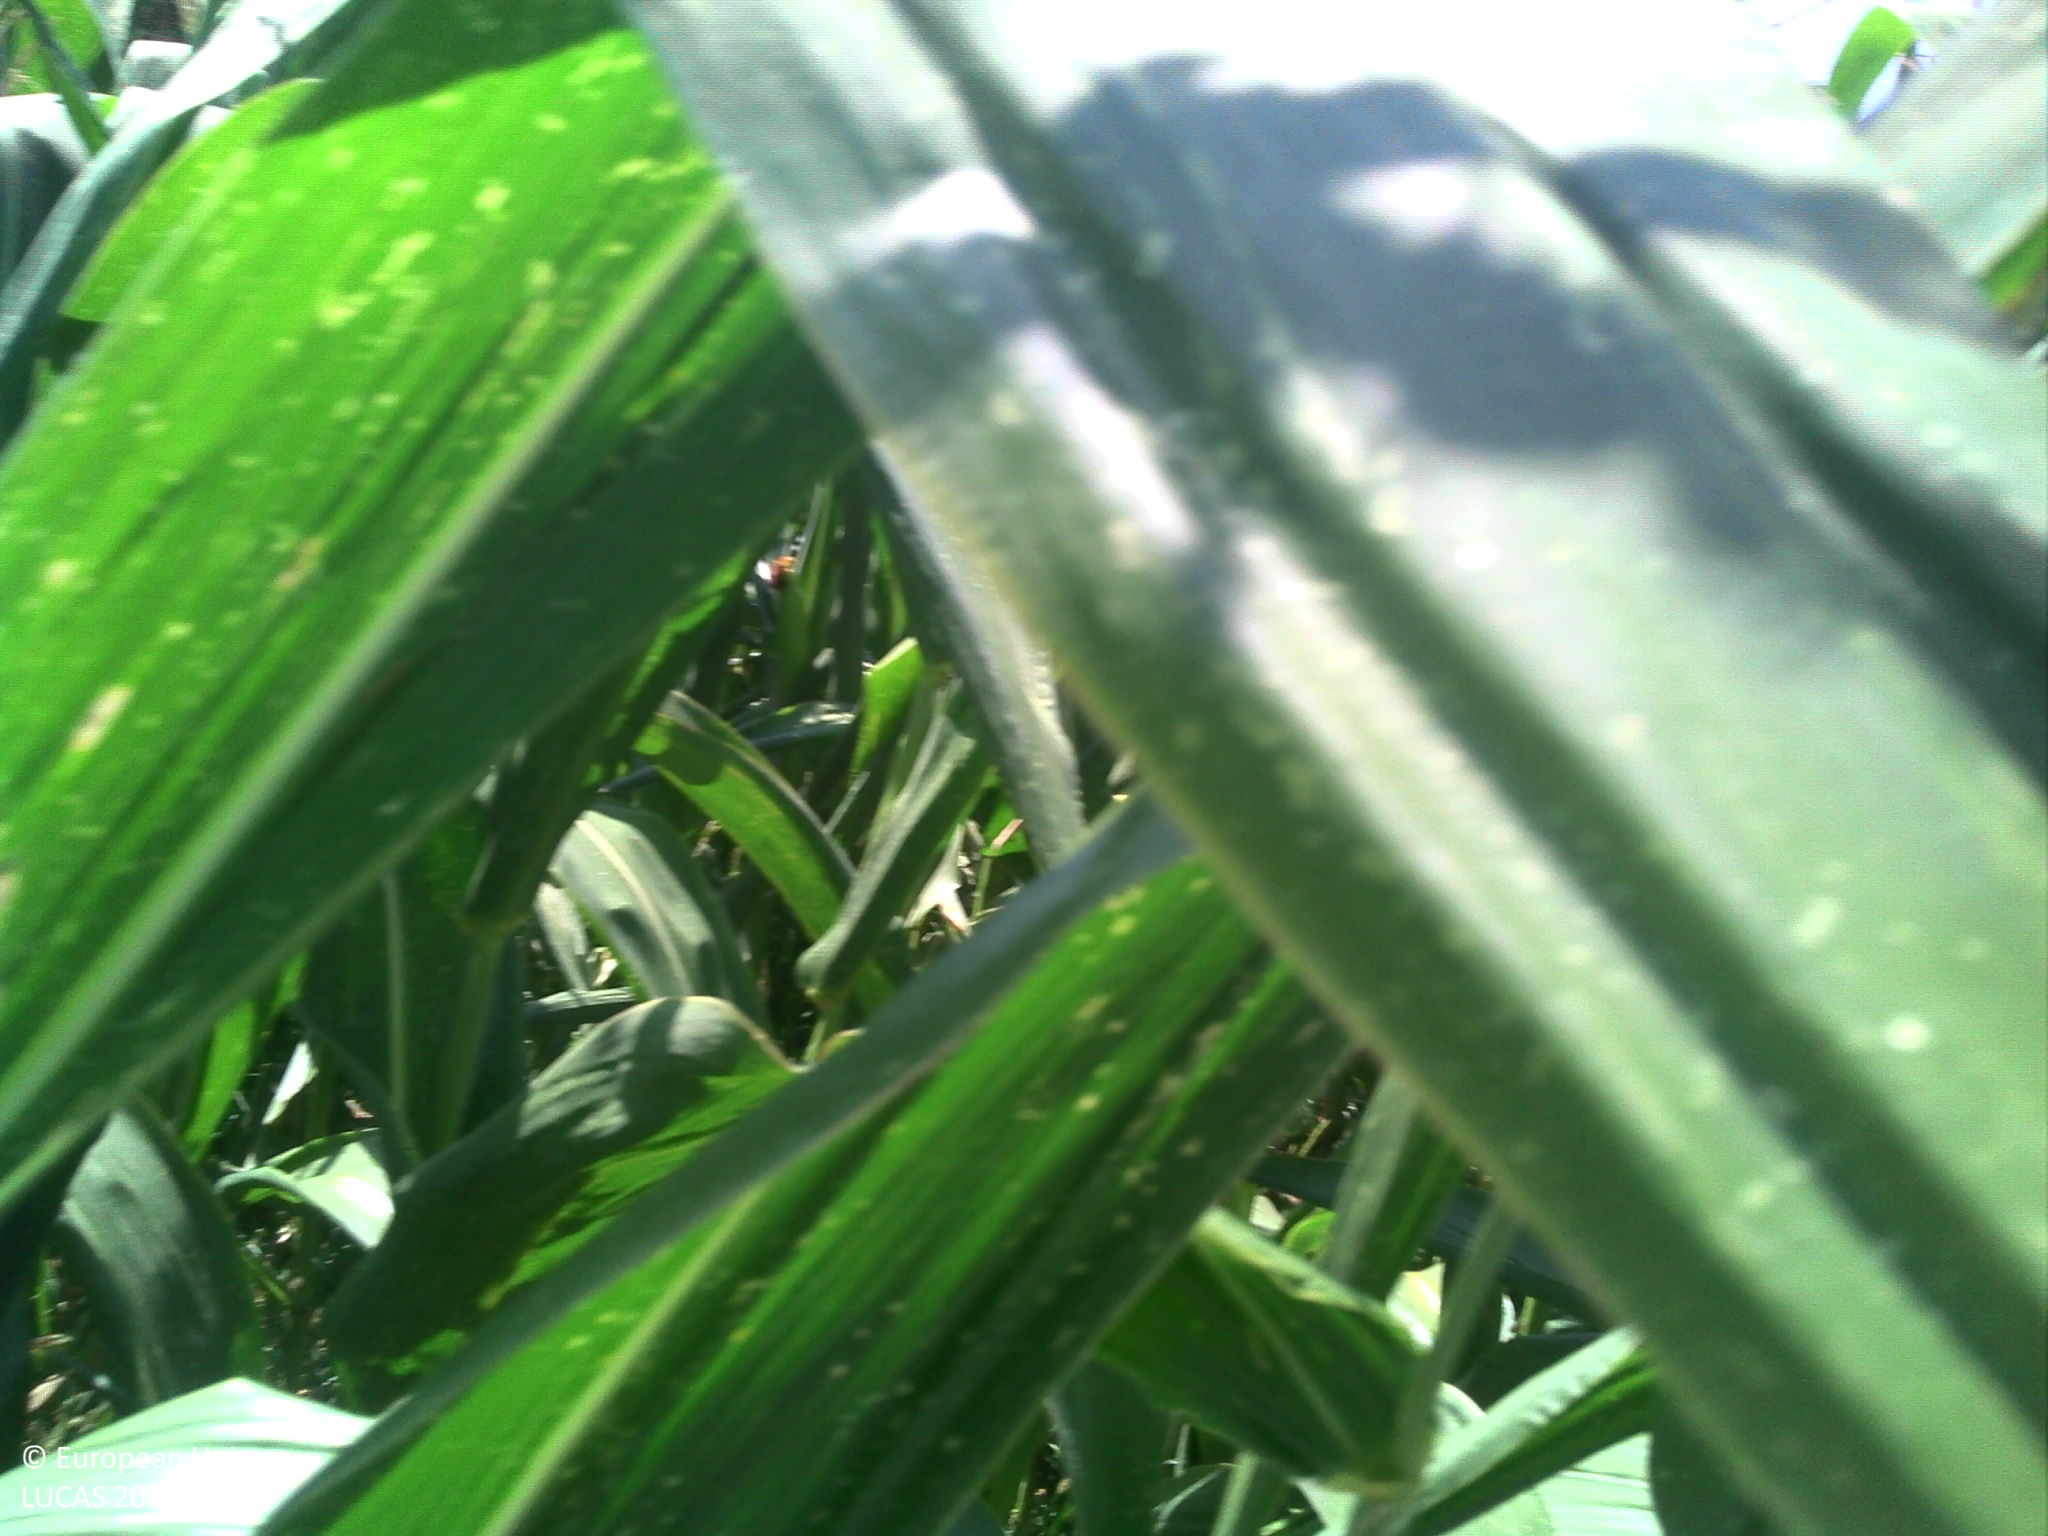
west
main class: Cropland
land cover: Maize
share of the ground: > 75 %
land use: Agriculture (excluding fallow land and kitchen gardens)
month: August
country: FR
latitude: 44.1865
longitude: 1.3294
